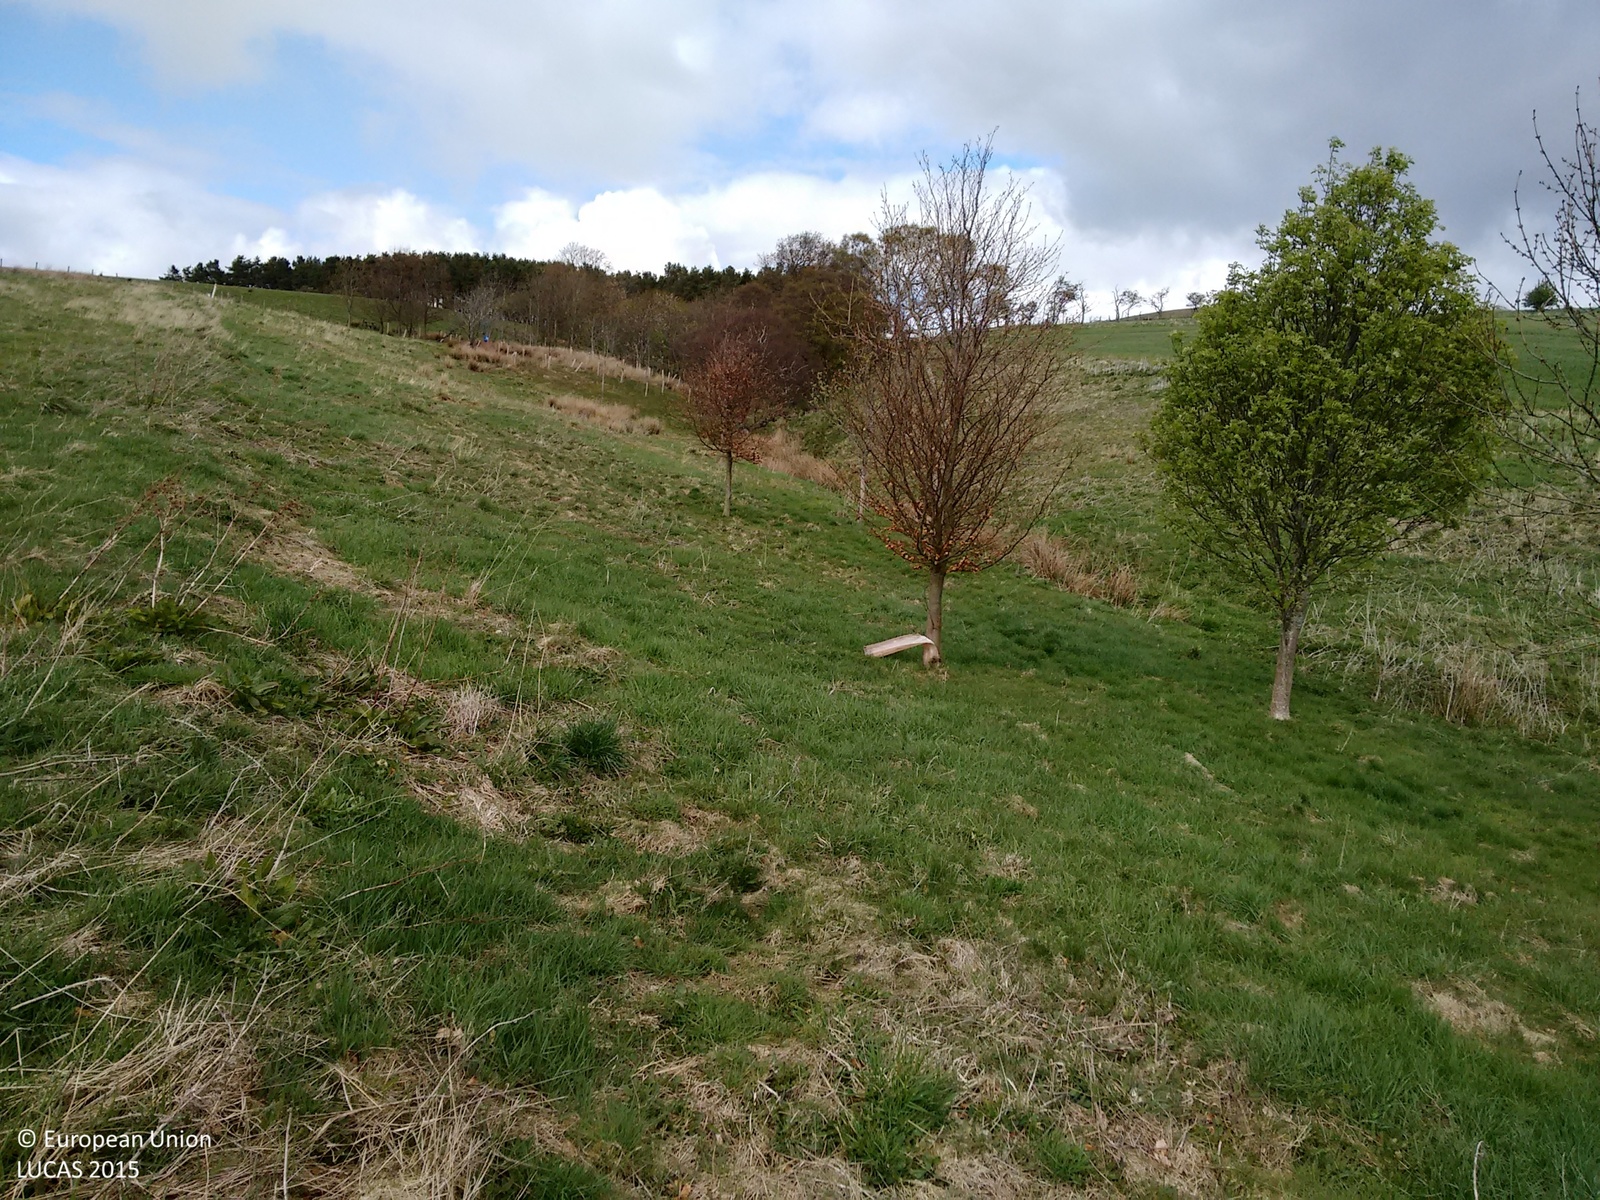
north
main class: Grassland
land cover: Grassland with sparse tree/shrub cover
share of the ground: > 75 %
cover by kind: herbaceous plants 95 %, broadleaved forest trees 5 %
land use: Semi-natural and natural areas not in use
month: May
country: GB
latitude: 54.8636
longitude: -1.9417
